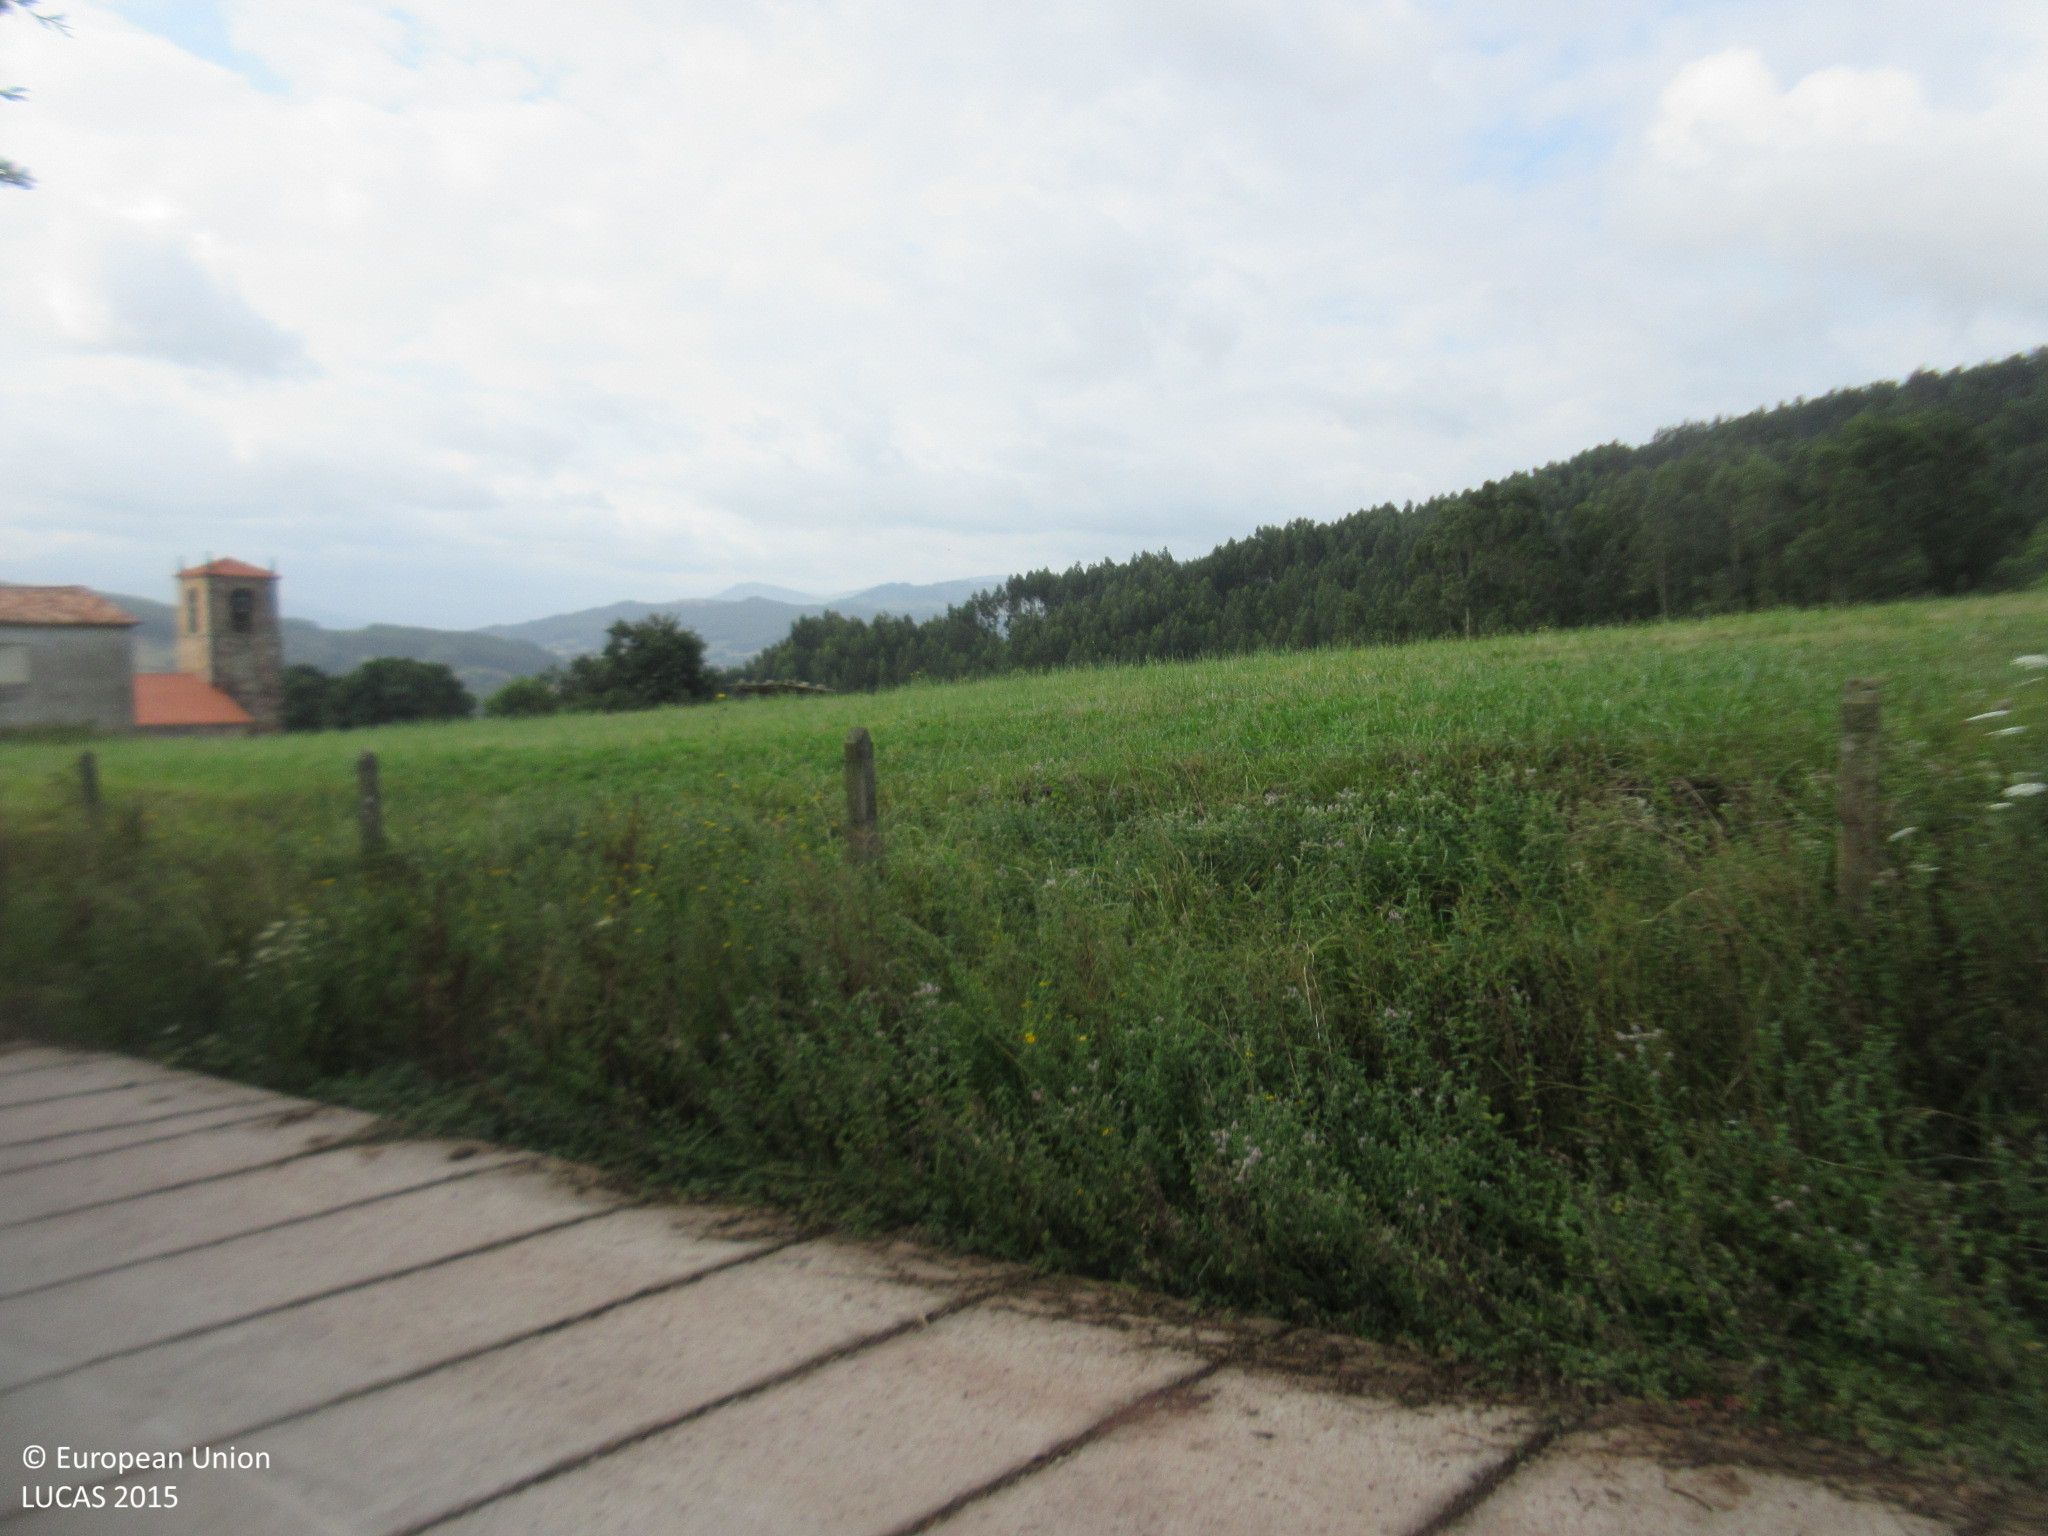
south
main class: Cropland
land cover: Apple fruit
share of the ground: 50 - 75 %
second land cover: Grassland without tree/shrub cover
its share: > 75 %
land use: Agriculture (excluding fallow land and kitchen gardens)
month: July
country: ES
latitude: 43.3619
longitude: -3.9823
